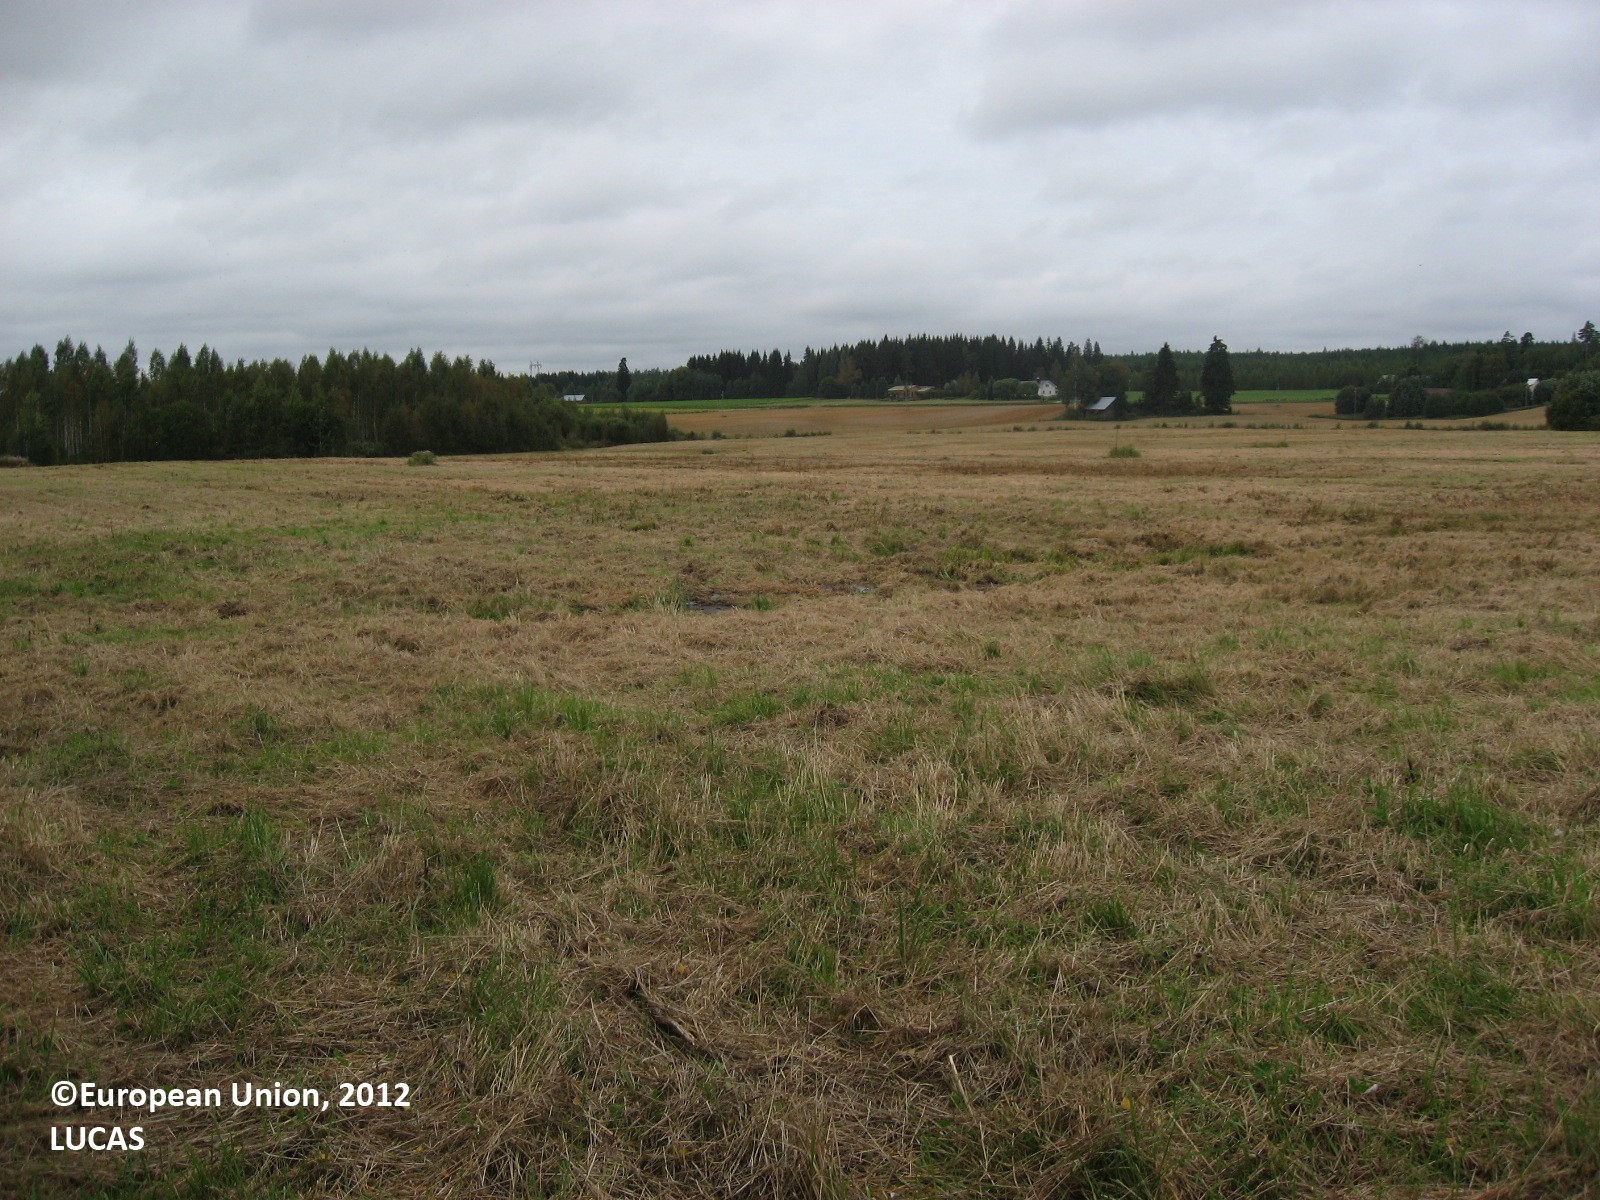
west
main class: Cropland
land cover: Temporary grasslands
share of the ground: > 75 %
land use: Agriculture (excluding fallow land and kitchen gardens)
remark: Harvested field
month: August
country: FI
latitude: 60.9557
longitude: 25.3181
